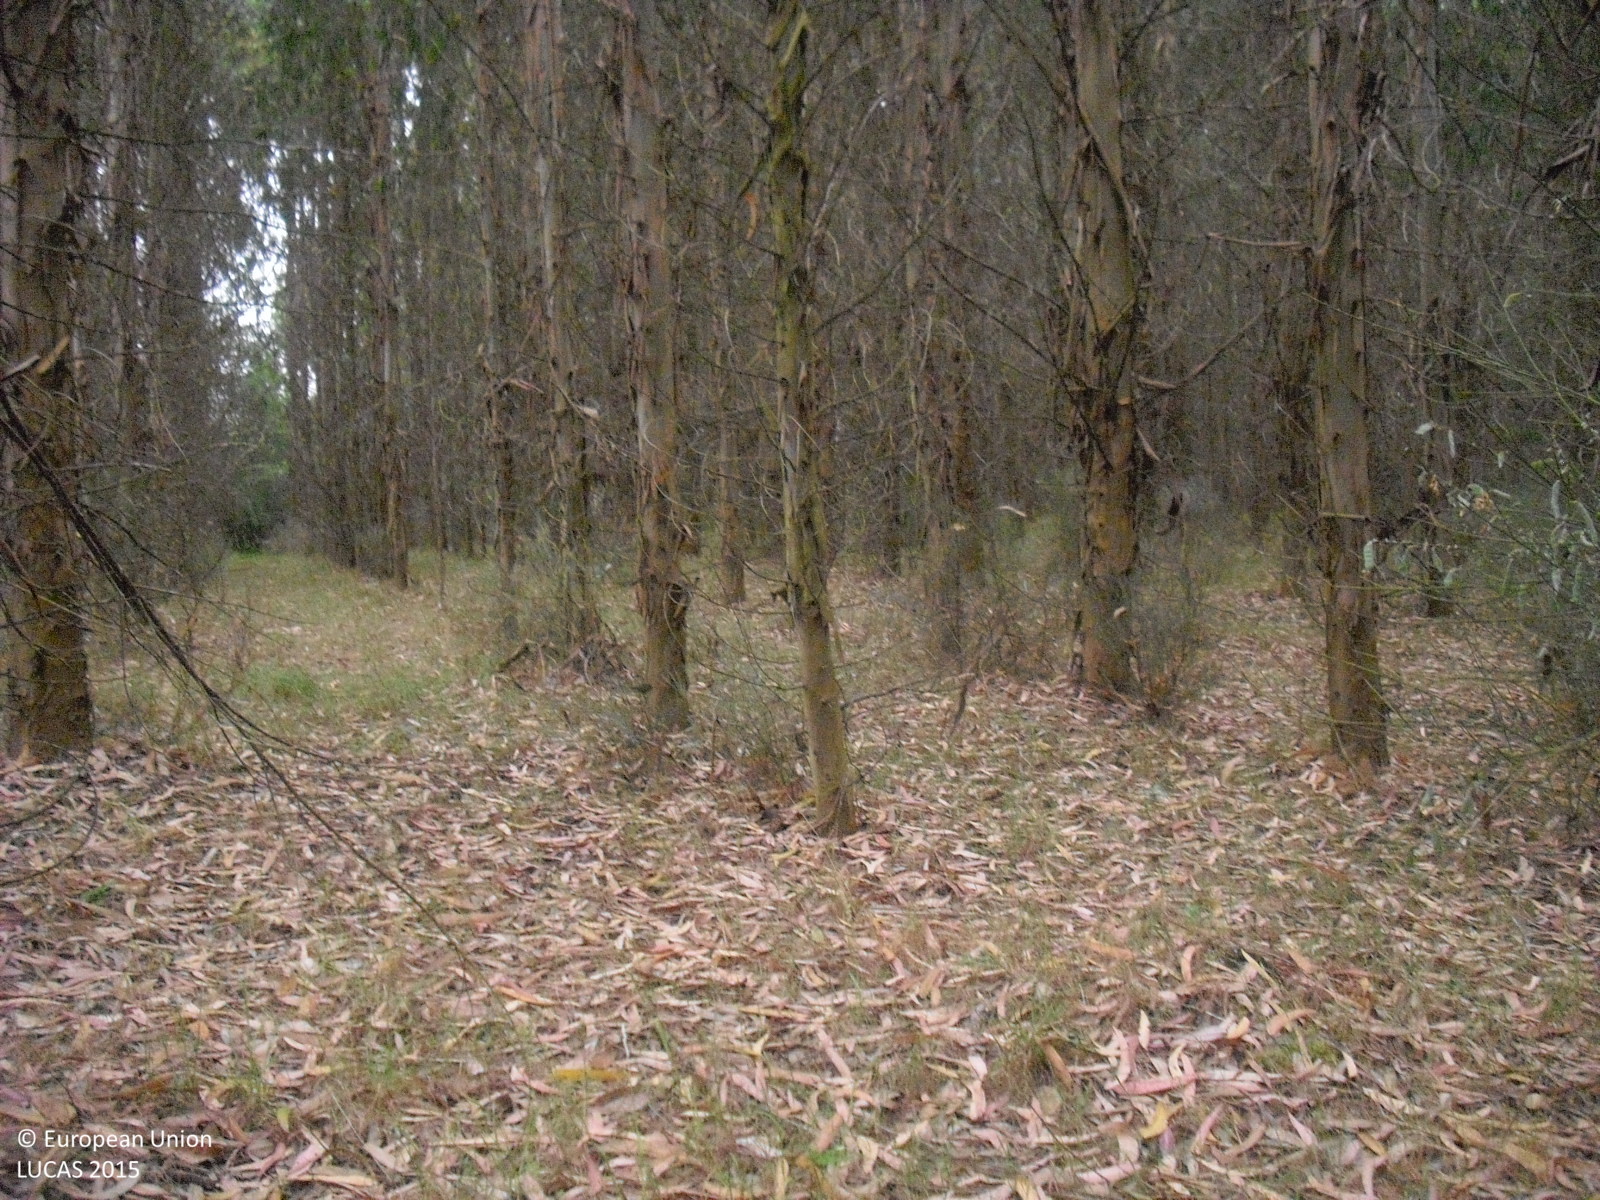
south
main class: Woodland
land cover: Broadleaved woodland
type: exotic forest
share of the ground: > 75 %
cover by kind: broadleaved forest trees 100 %
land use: Forestry
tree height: > 5 m
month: June
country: ES
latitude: 42.7665
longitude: -7.8637
